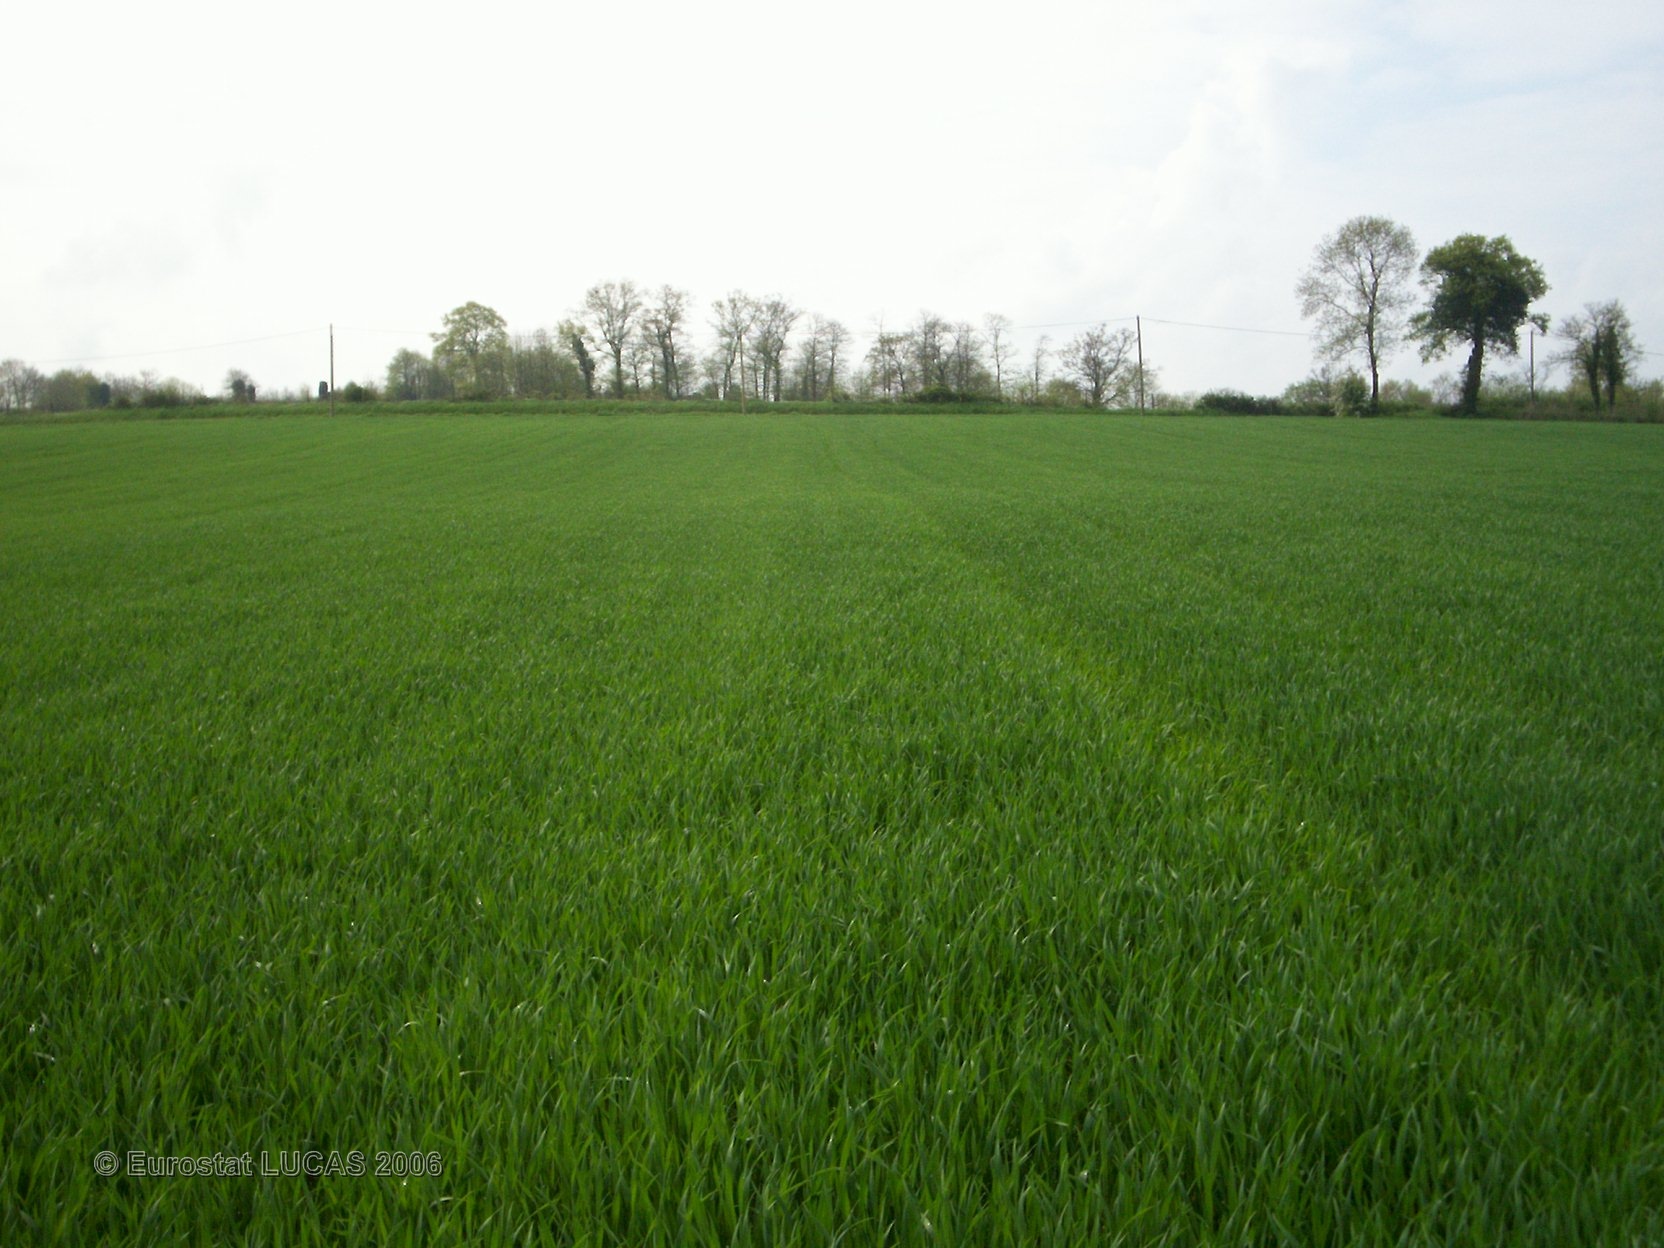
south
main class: Cropland
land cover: Common wheat
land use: Agriculture (excluding fallow land and kitchen gardens)
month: April
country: FR
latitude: 47.8326
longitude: -1.5476
